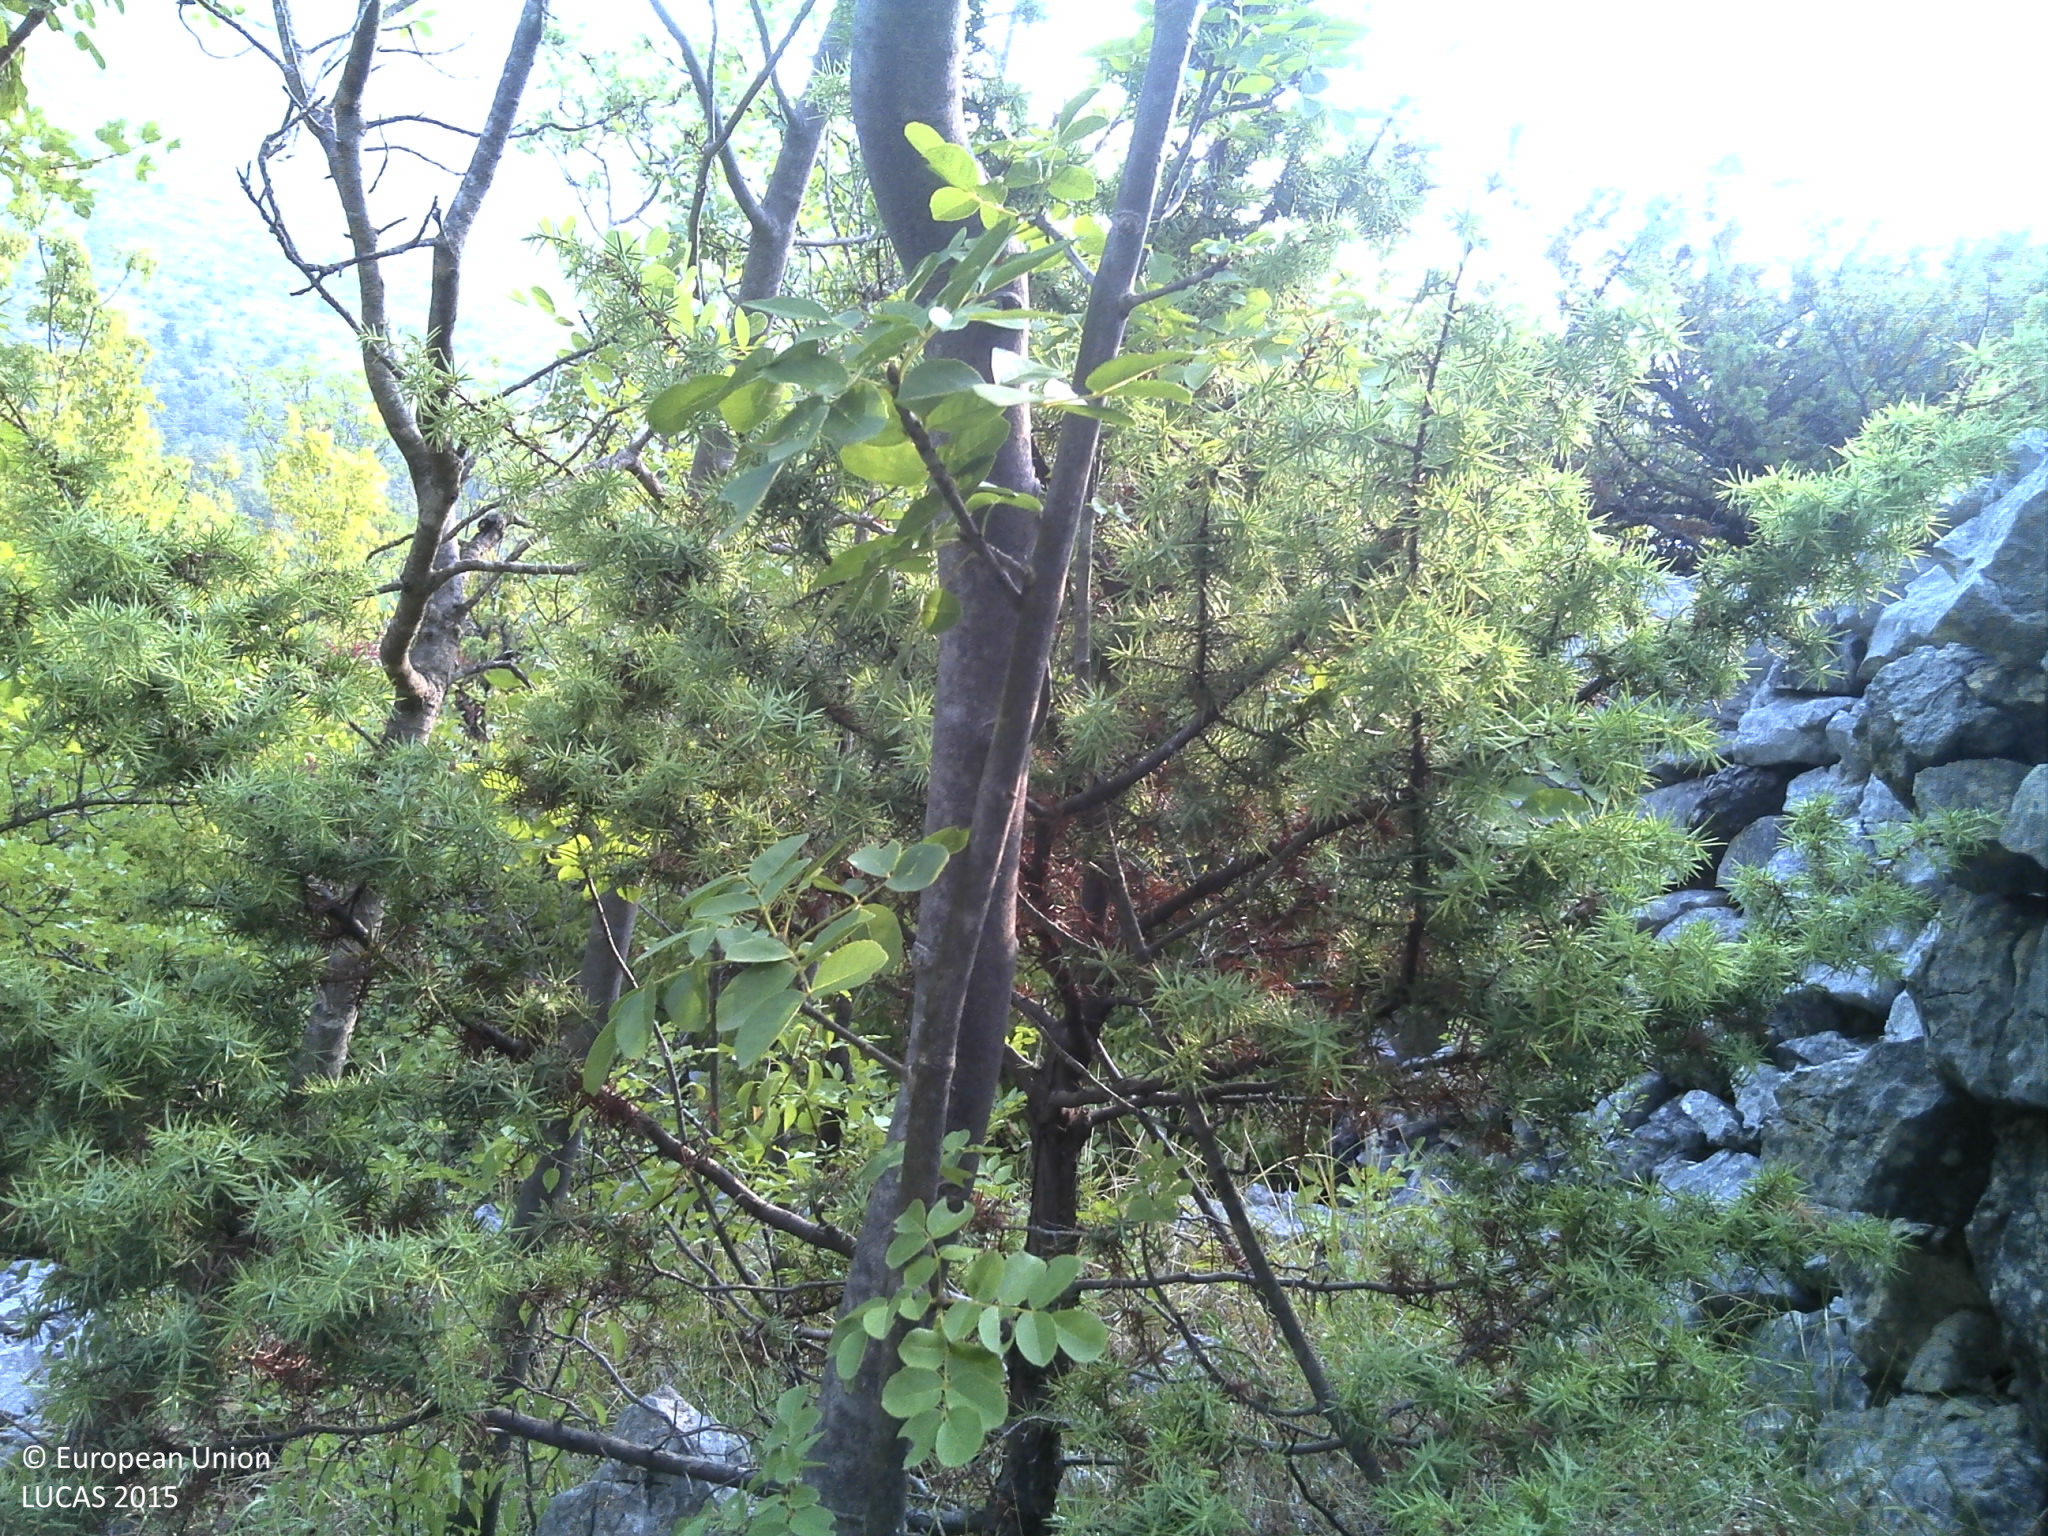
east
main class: Shrubland
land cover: Shrubland with sparse tree cover
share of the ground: > 75 %
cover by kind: shrubs 75 %, herbaceous plants 10 %, consolidated bare surface 10 %, broadleaved forest trees 5 %
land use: Abandoned areas
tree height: < 5 m
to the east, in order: Shrubland with sparse tree cover; Dry stone walls; Shrubland with sparse tree cover; Dry stone walls; Shrubland with sparse tree cover; Dry stone walls; Shrubland with sparse tree cover; Paved roads, cycling and walking lanes; Shrubland with sparse tree cover; Grassland with sparse tree/shrub cover
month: August
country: HR
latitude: 43.2460
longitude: 17.2452
